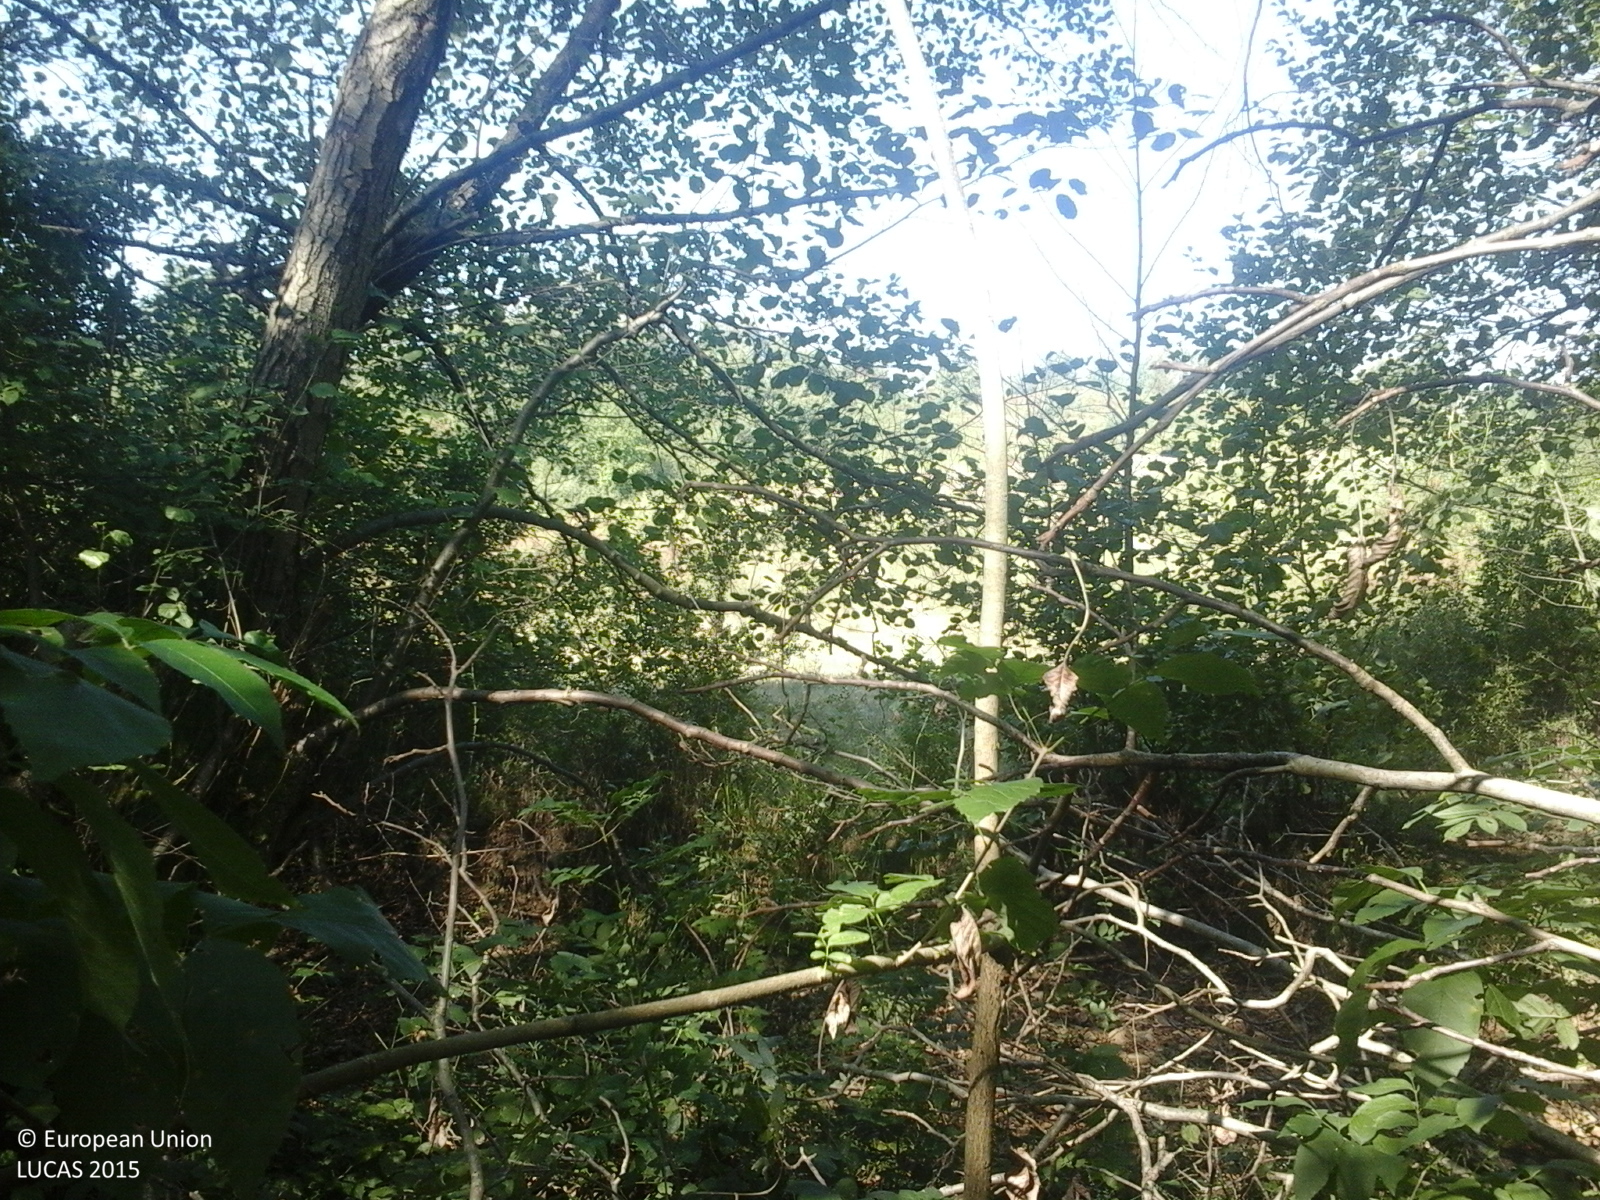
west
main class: Woodland
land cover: Broadleaved woodland
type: non-riverine alder, birch or aspen forest
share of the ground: > 75 %
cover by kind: broadleaved forest trees 100 %
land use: Forestry
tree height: > 5 m
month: August
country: RO
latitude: 46.4311
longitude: 22.2148
